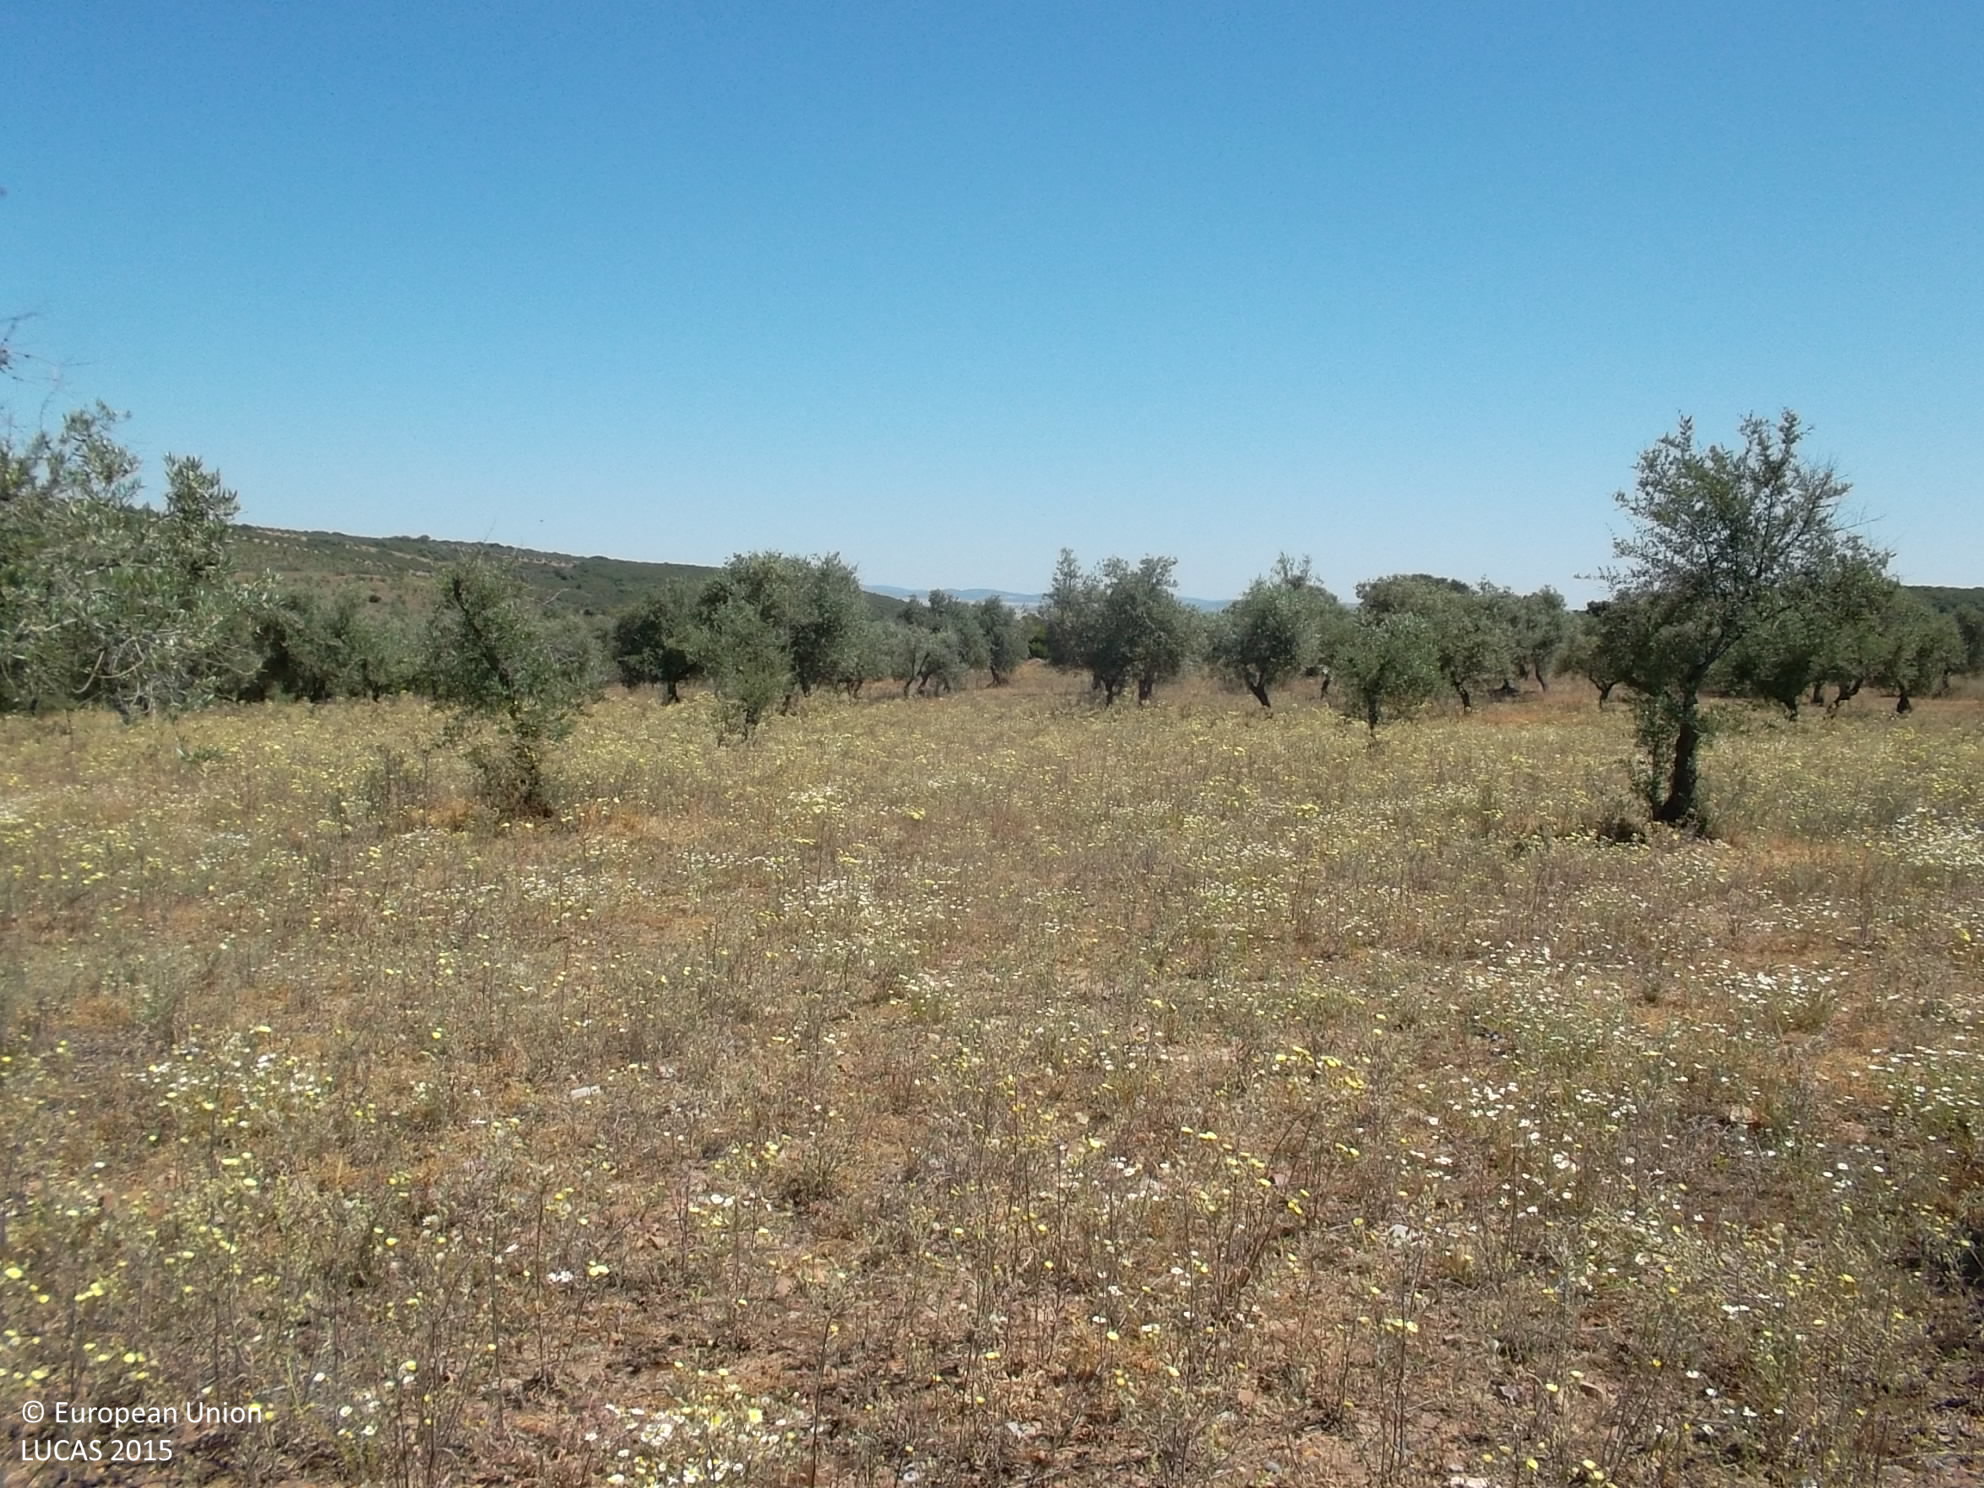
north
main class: Cropland
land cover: Olive groves
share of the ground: 25 - 50 %
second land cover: Spontaneously vegetated surfaces
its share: 50 - 75 %
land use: Agriculture (excluding fallow land and kitchen gardens)
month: May
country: ES
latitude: 38.7910
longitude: -4.4267
